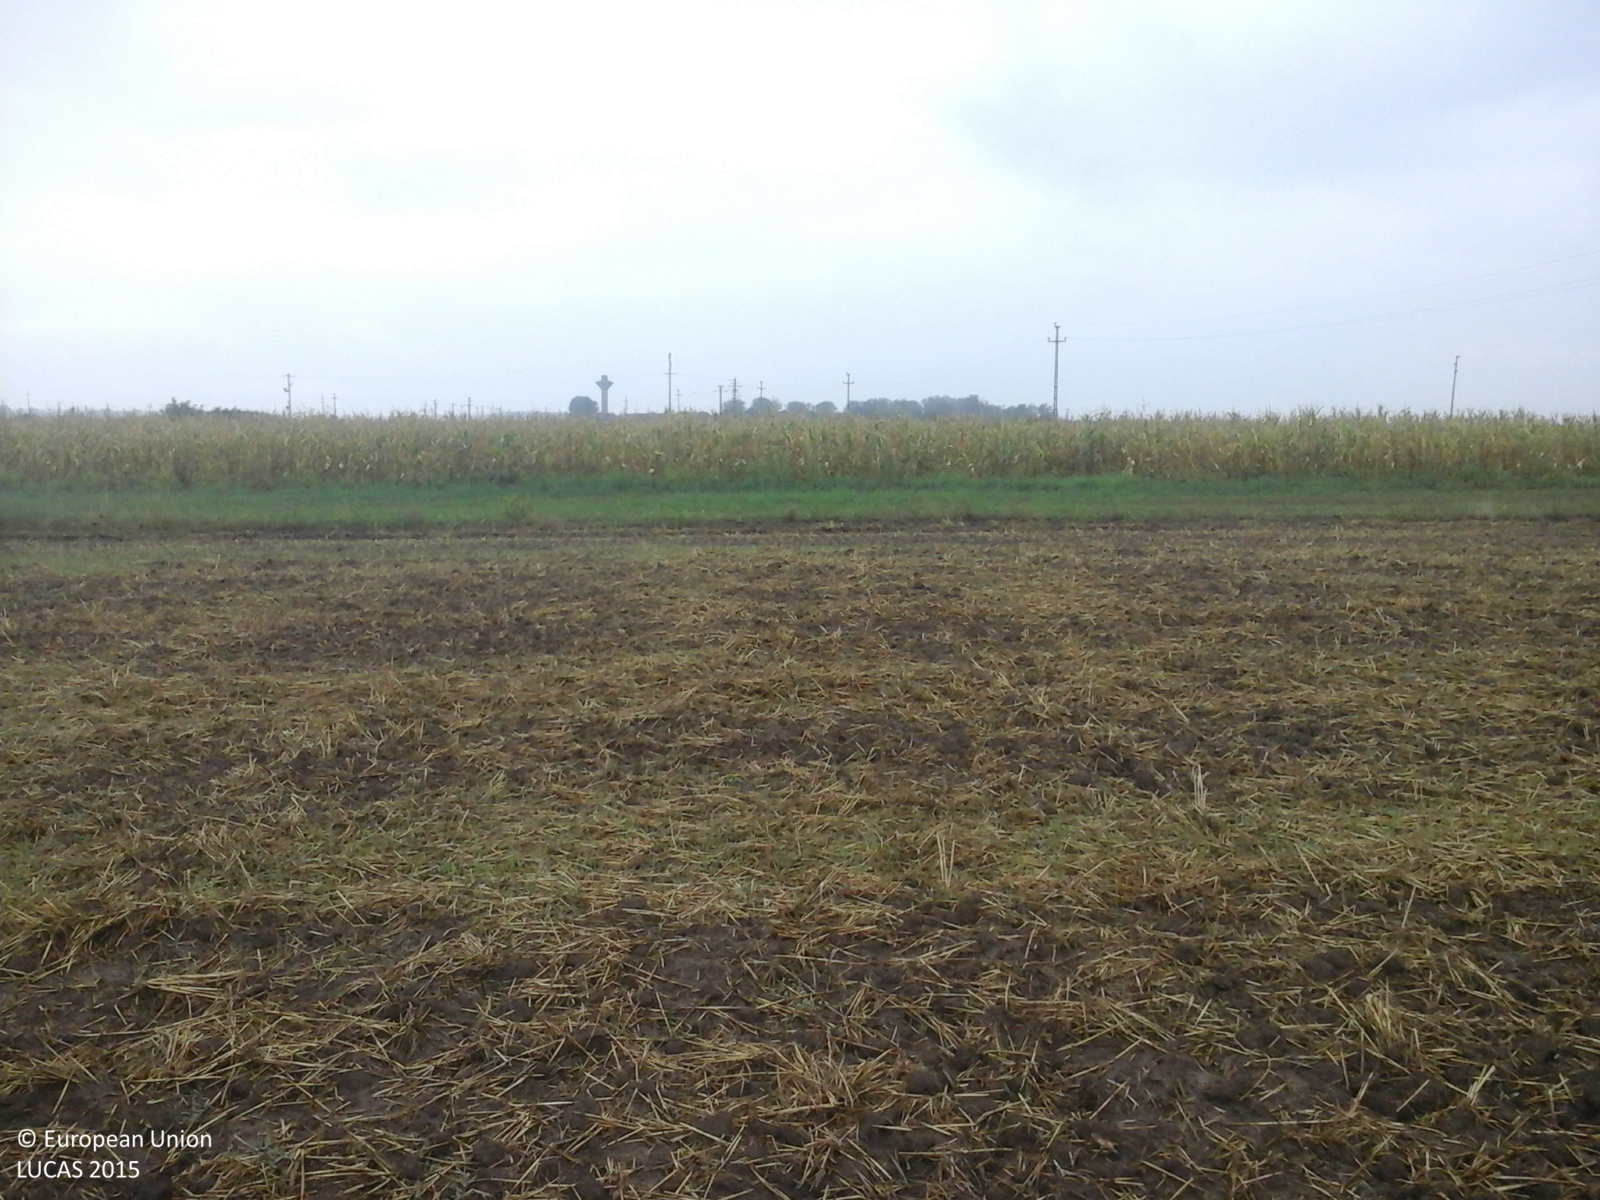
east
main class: Cropland
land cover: Common wheat
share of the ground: < 10 %
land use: Agriculture (excluding fallow land and kitchen gardens)
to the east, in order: Common wheat; Grass margins; Lucerne; Maize; Common wheat; Abandoned hedges; Ditches and canals; Abandoned hedges; Common wheat
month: August
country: RO
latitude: 45.6211
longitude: 21.1483
